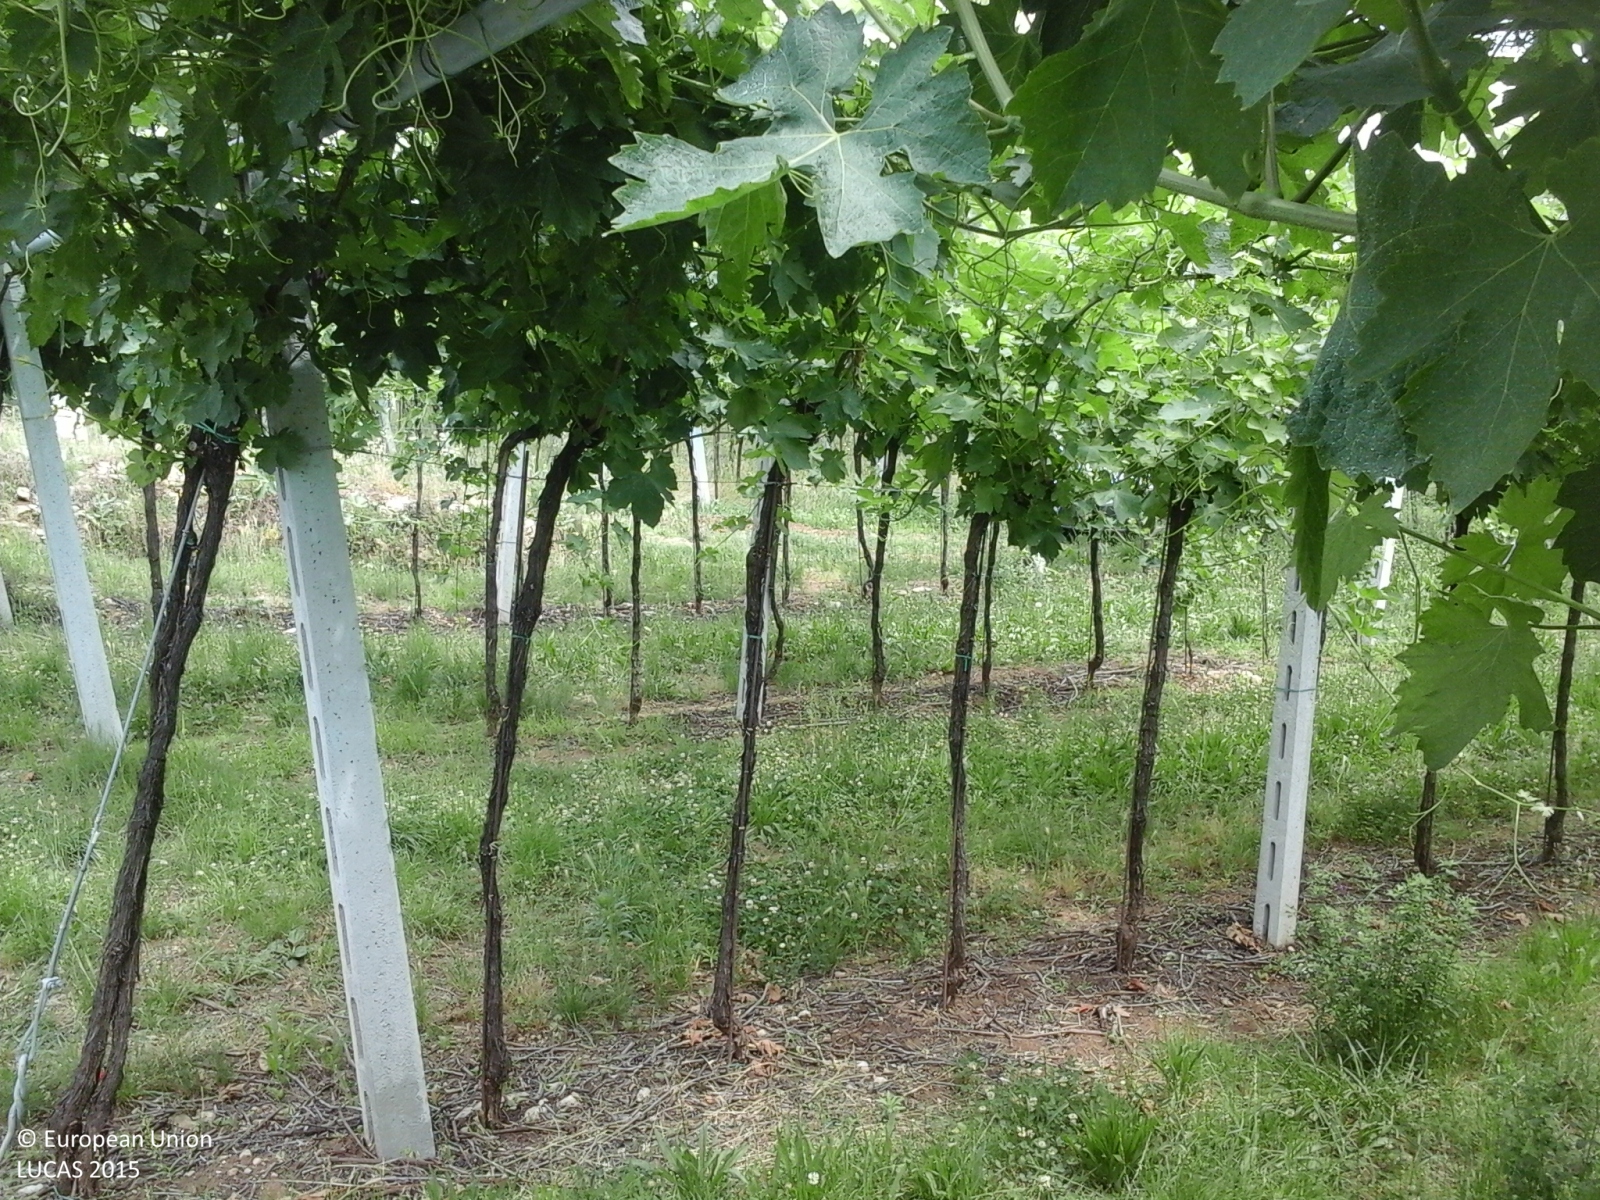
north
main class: Cropland
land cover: Vineyards
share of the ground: > 75 %
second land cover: Grassland without tree/shrub cover
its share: > 75 %
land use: Agriculture (excluding fallow land and kitchen gardens)
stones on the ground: < 10 %
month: June
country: IT
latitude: 45.5546
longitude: 10.9080
